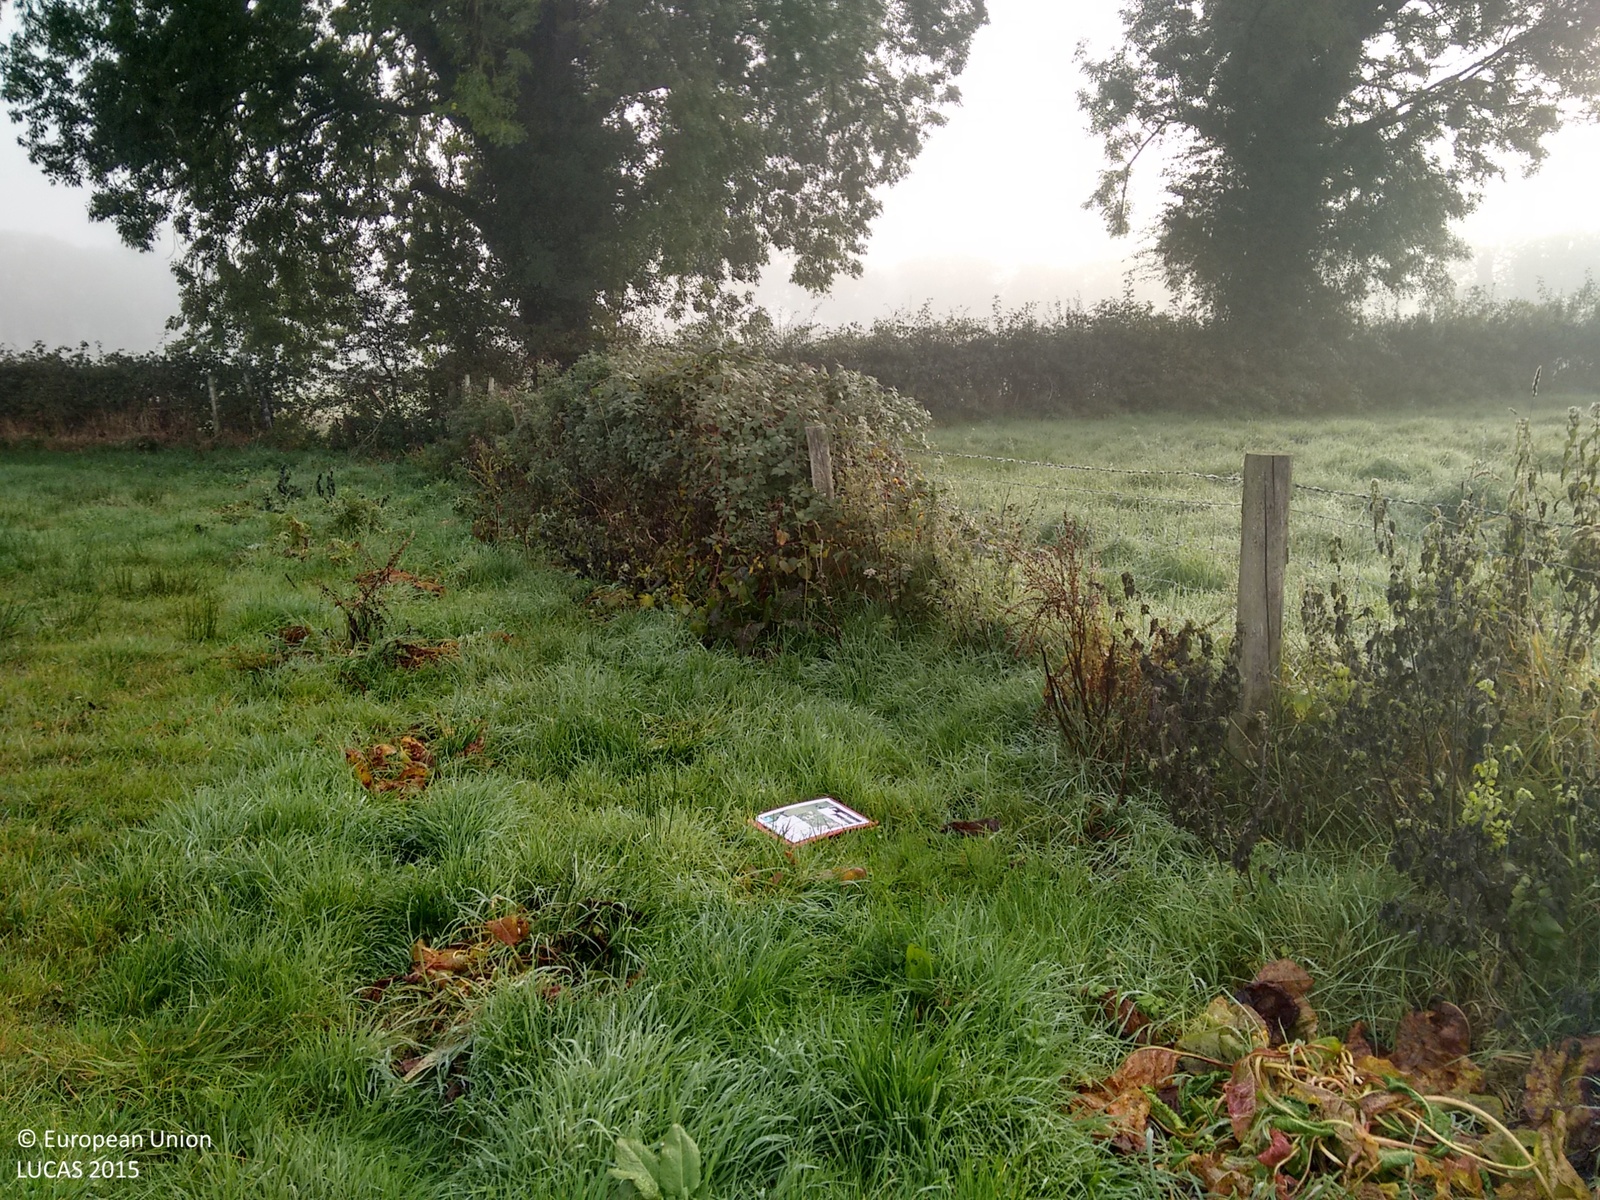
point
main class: Grassland
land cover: Grassland without tree/shrub cover
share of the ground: > 75 %
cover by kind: herbaceous plants 100 %
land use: Agriculture (excluding fallow land and kitchen gardens)
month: October
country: GB
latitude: 54.2878
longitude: -7.7543
